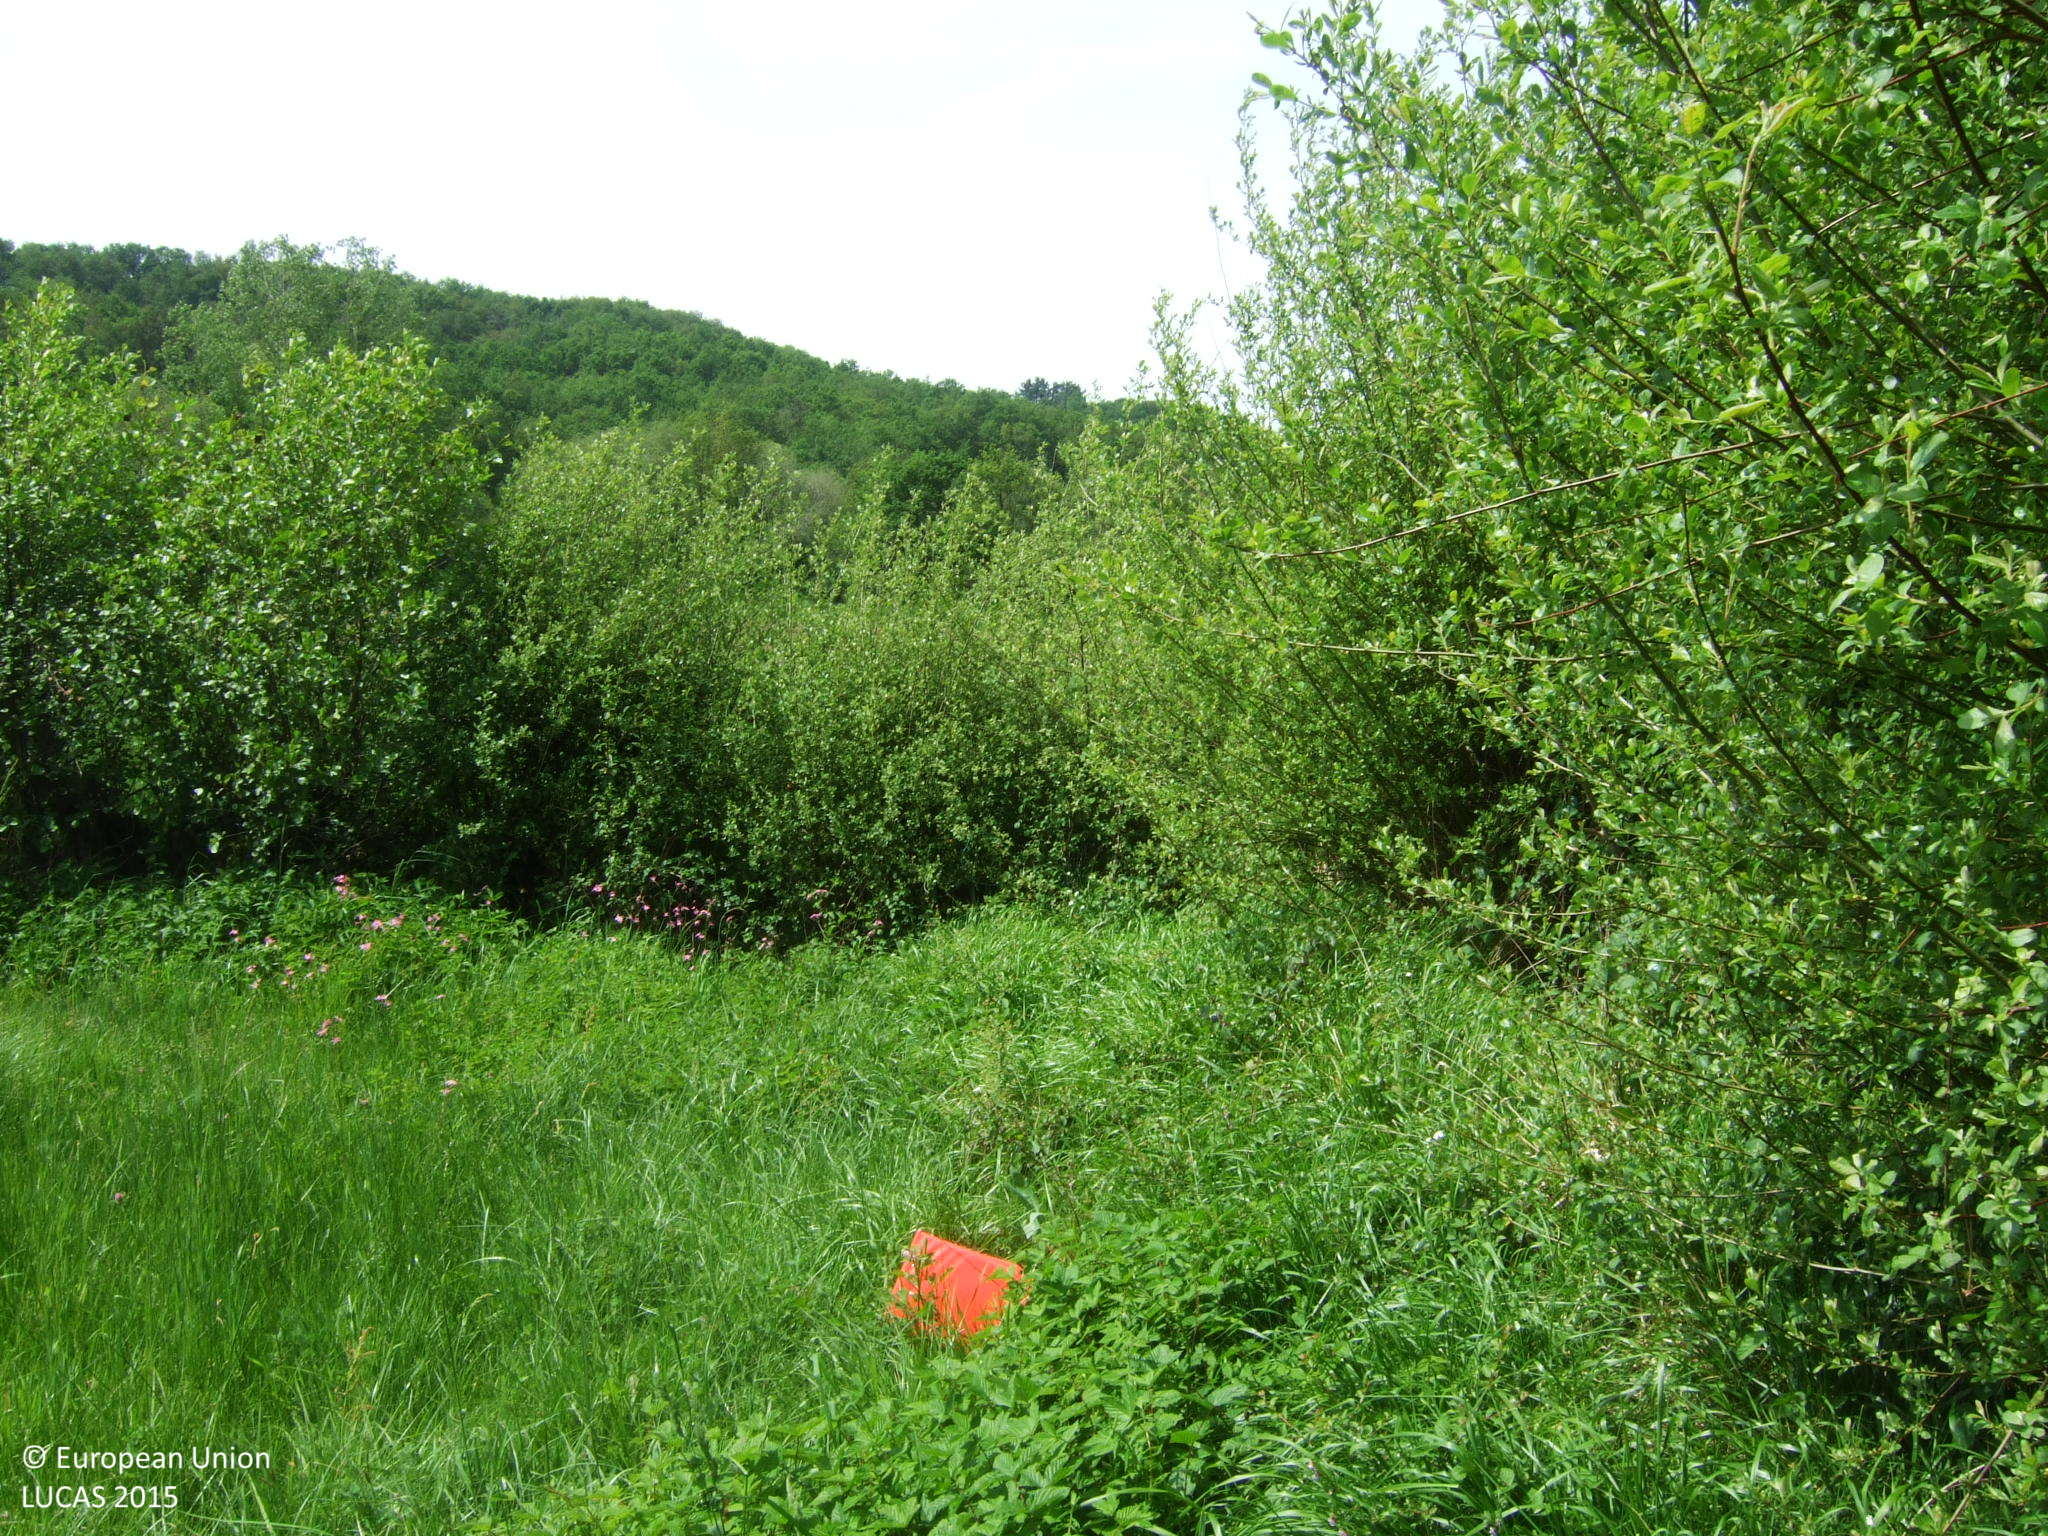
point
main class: Grassland
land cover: Grassland without tree/shrub cover
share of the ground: > 75 %
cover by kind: herbaceous plants 100 %
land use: Agriculture (excluding fallow land and kitchen gardens)
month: May
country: ES
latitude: 42.8372
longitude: -7.3569
